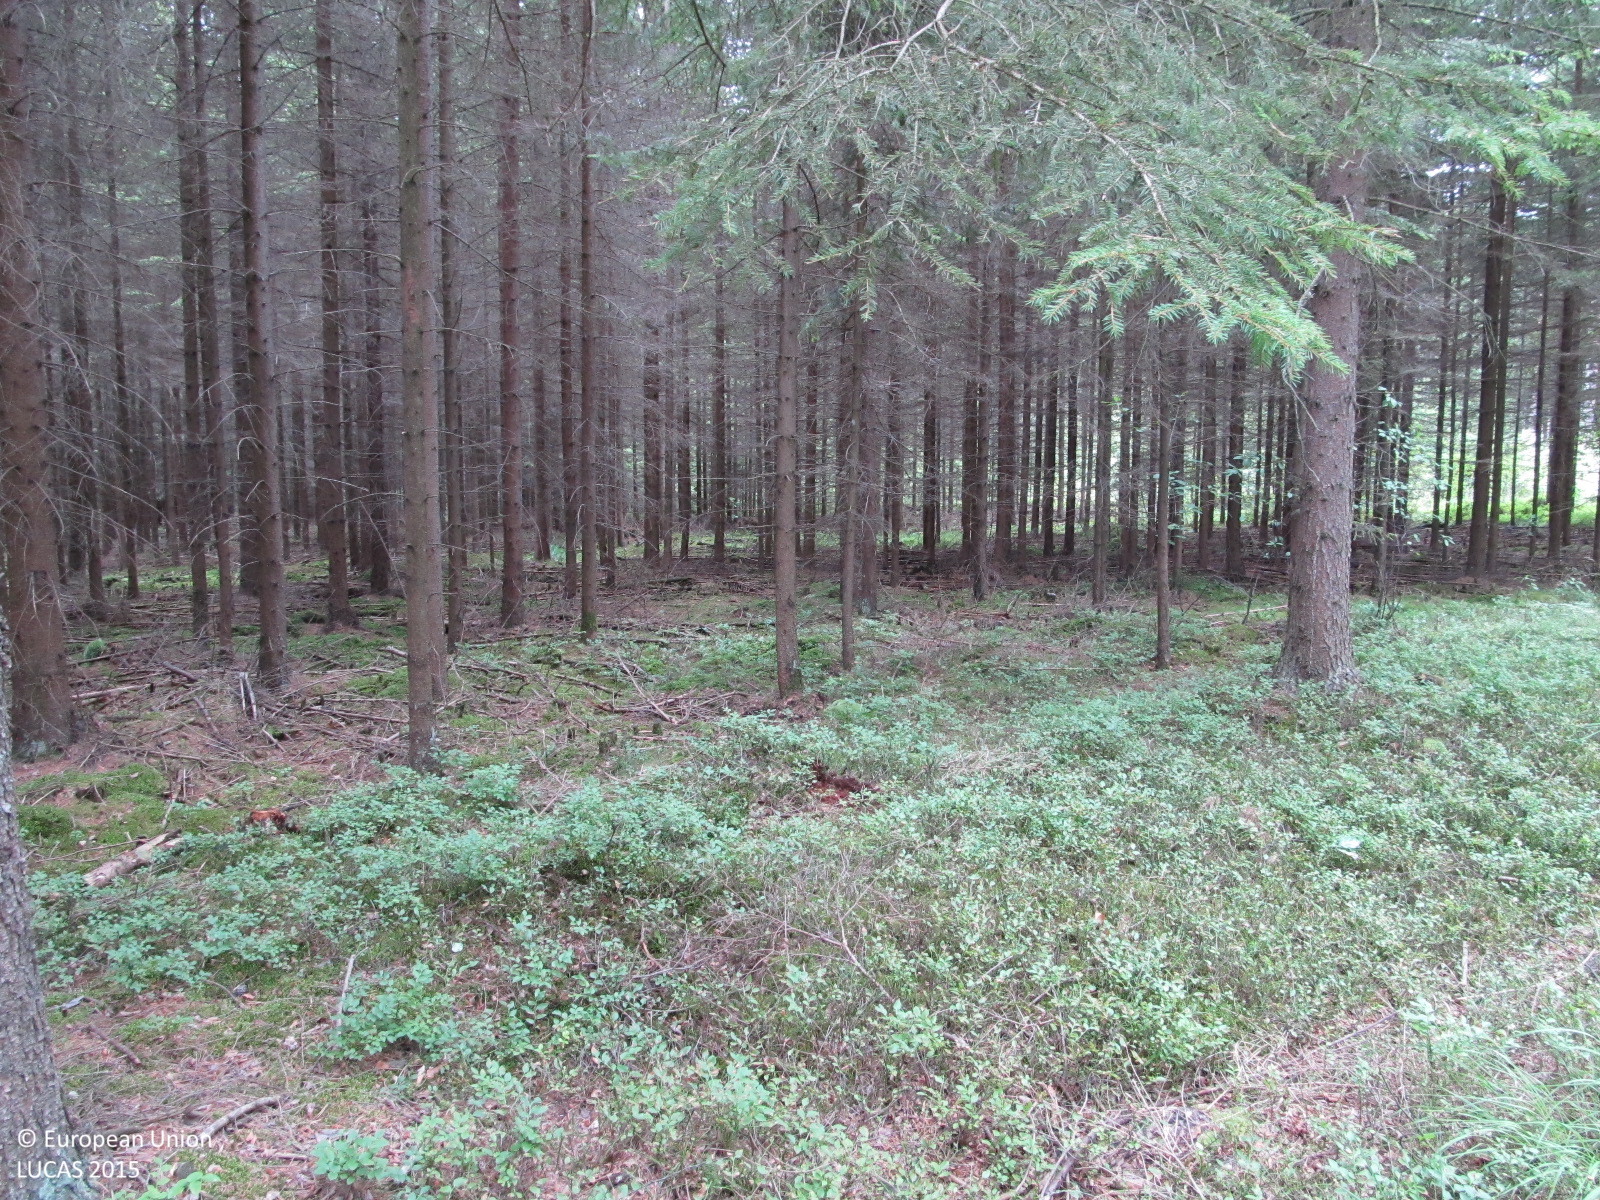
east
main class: Woodland
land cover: Spruce dominated coniferous woodland
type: hemiboreal forest and nemoral coniferous forest and mixed broadleaved-coniferous forest
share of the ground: > 75 %
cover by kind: coniferous forest trees 85 %, shrubs 5 %, herbaceous plants 5 %, lichens and mosses 5 %
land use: Forestry
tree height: > 5 m
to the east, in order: Spruce dominated coniferous woodland; Tracks; Spruce dominated coniferous woodland; Tracks; Spruce dominated coniferous woodland; Ditches and canals; Spruce dominated coniferous woodland; Spruce dominated mixed woodland; Spruce dominated coniferous woodland; Spruce dominated mixed woodland; Spruce dominated coniferous woodland; Grassland without tree/shrub cover; Paved roads, cycling and walking lanes; Grass margins
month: July
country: AT
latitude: 48.7581
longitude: 15.0214
